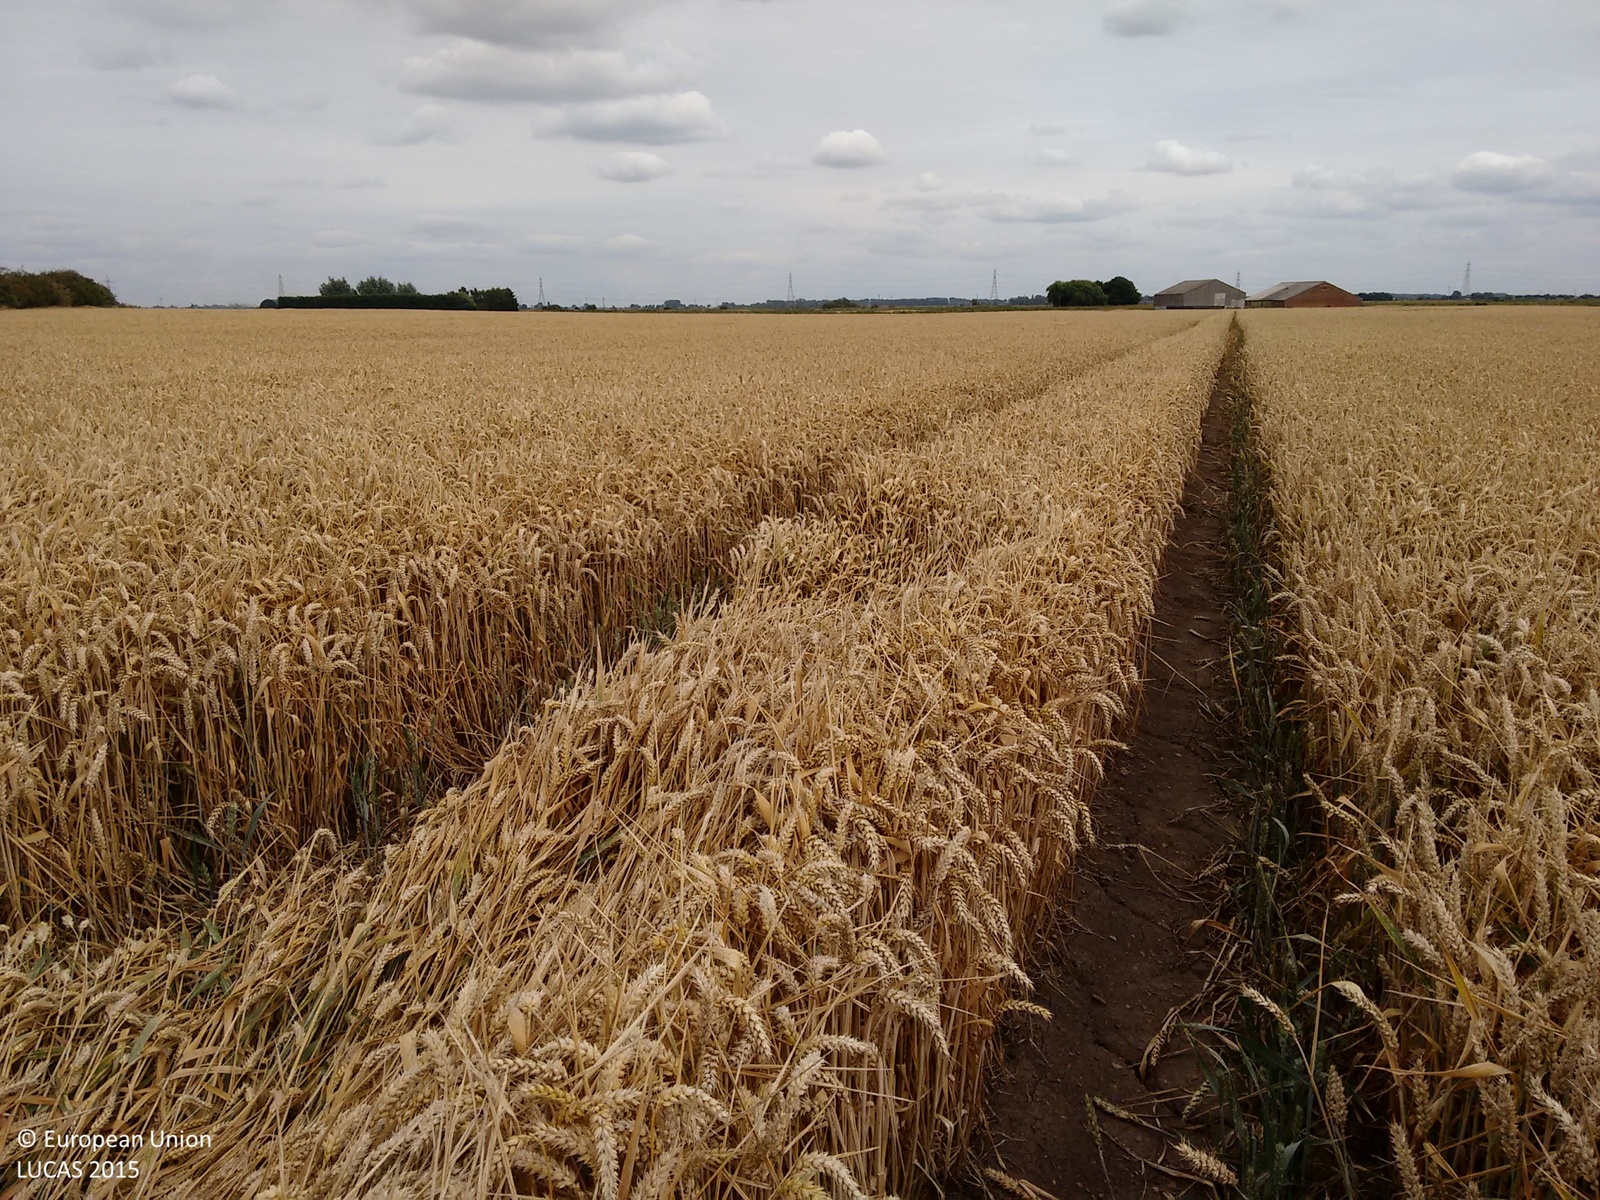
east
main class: Cropland
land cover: Common wheat
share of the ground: > 75 %
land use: Agriculture (excluding fallow land and kitchen gardens)
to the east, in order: Common wheat
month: August
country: GB
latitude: 52.4861
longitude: 0.2954
